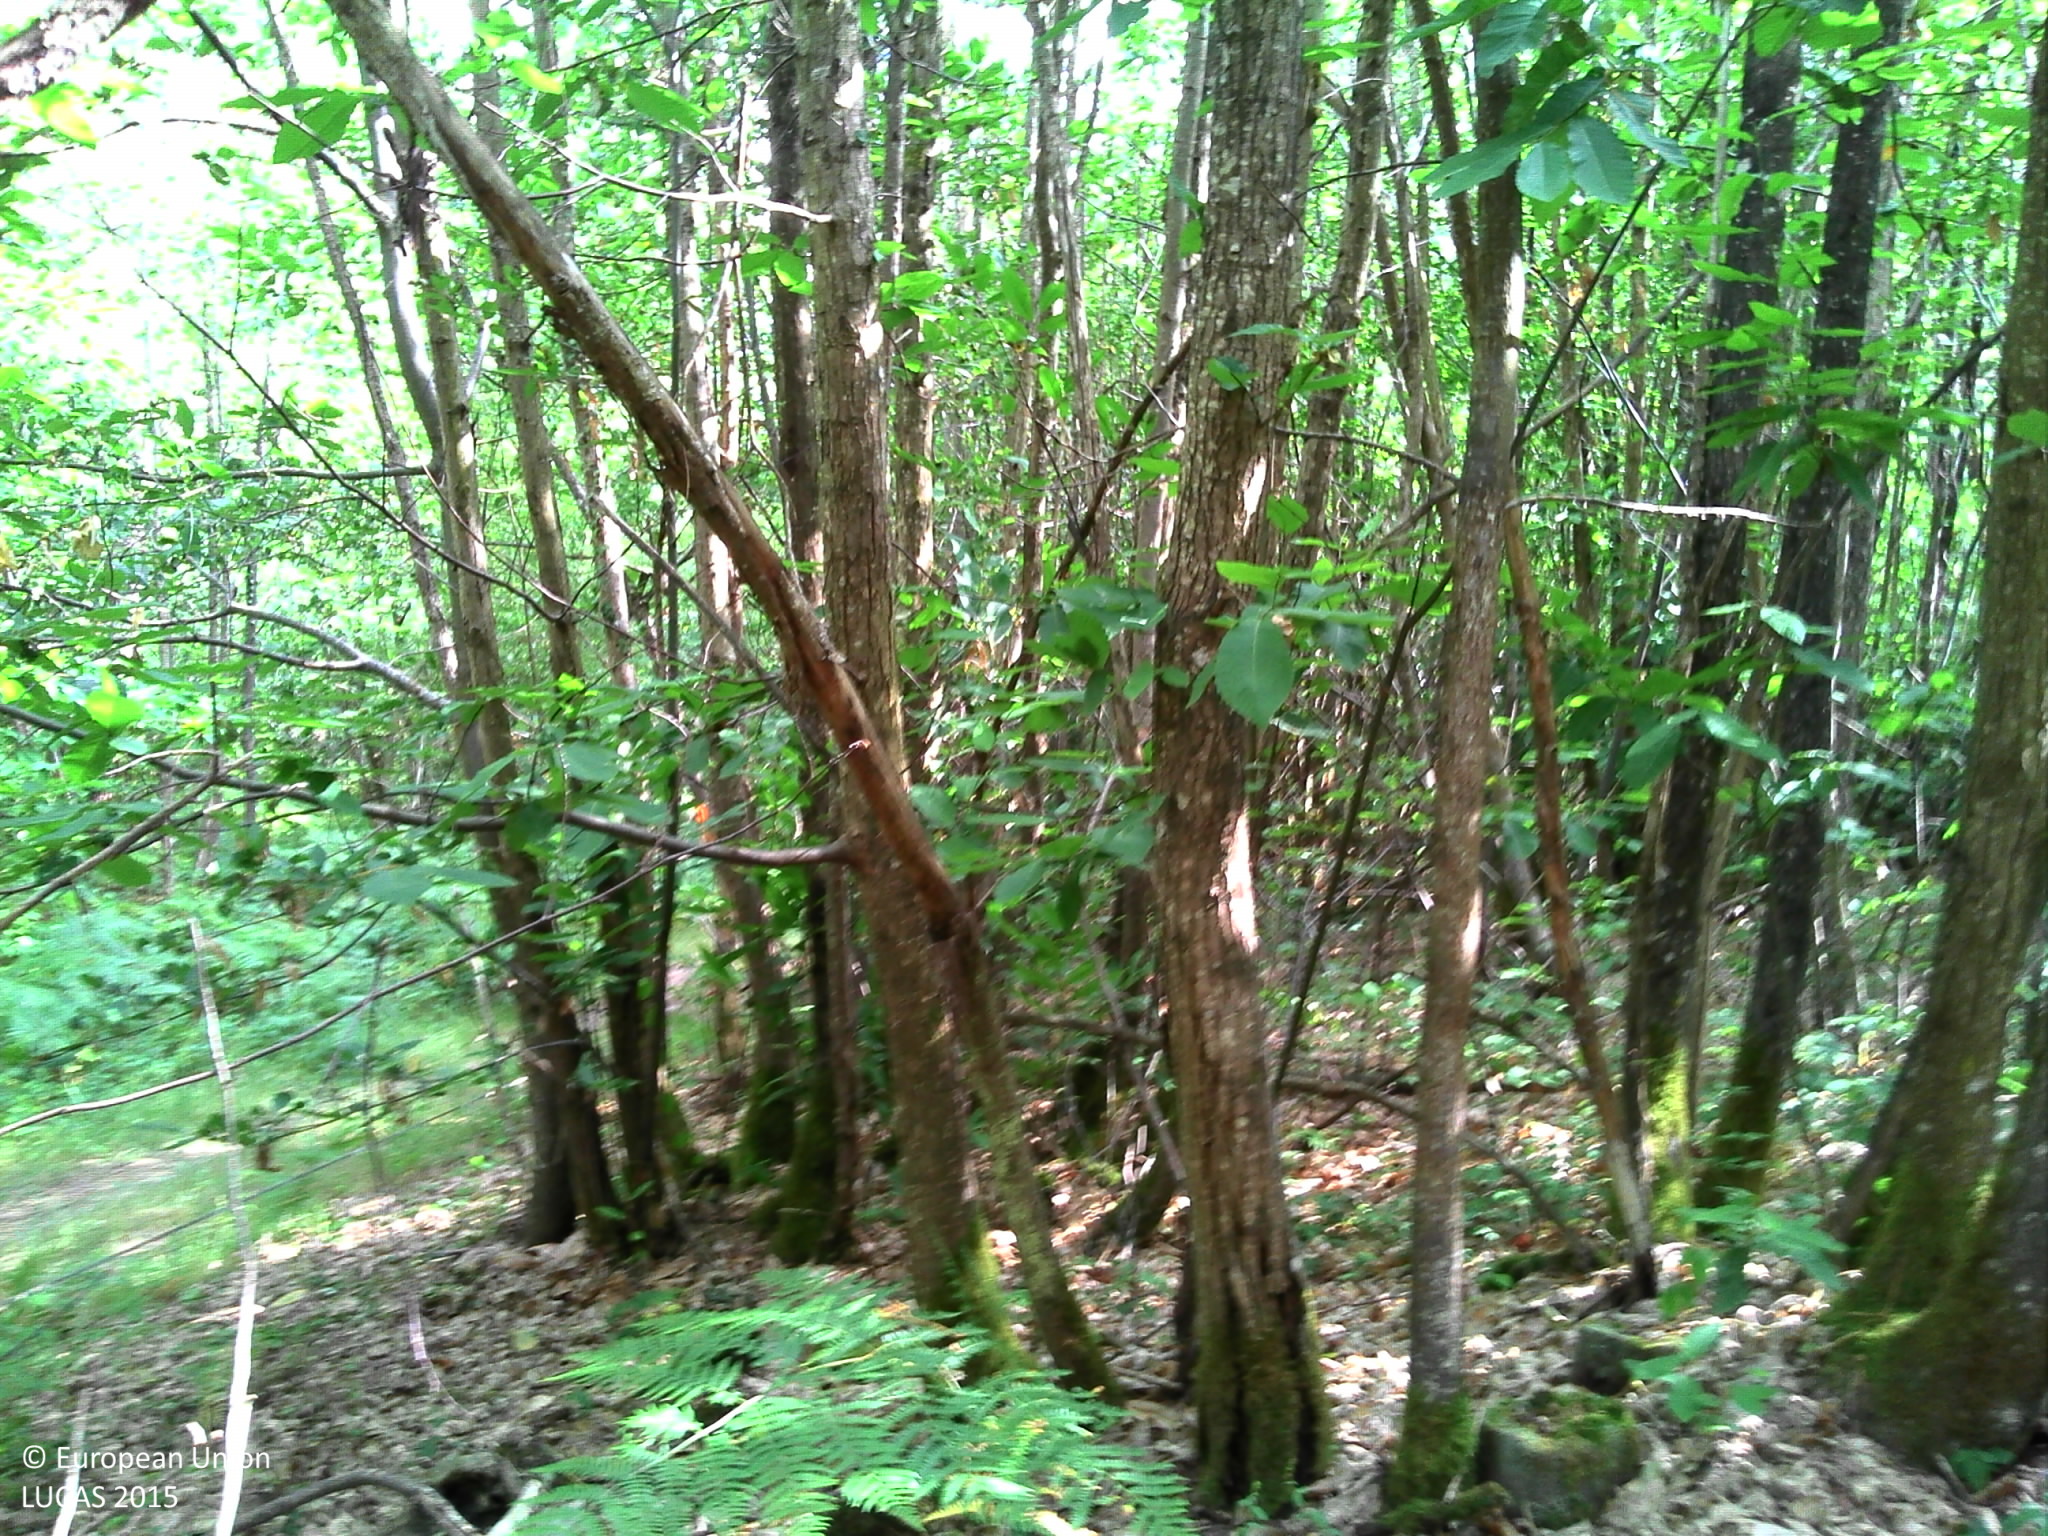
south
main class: Woodland
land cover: Broadleaved woodland
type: thermophilous deciduous forest
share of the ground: > 75 %
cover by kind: broadleaved forest trees 80 %, shrubs 10 %, herbaceous plants 10 %
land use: Forestry
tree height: > 5 m
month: July
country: FR
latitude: 45.0933
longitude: 0.7020
